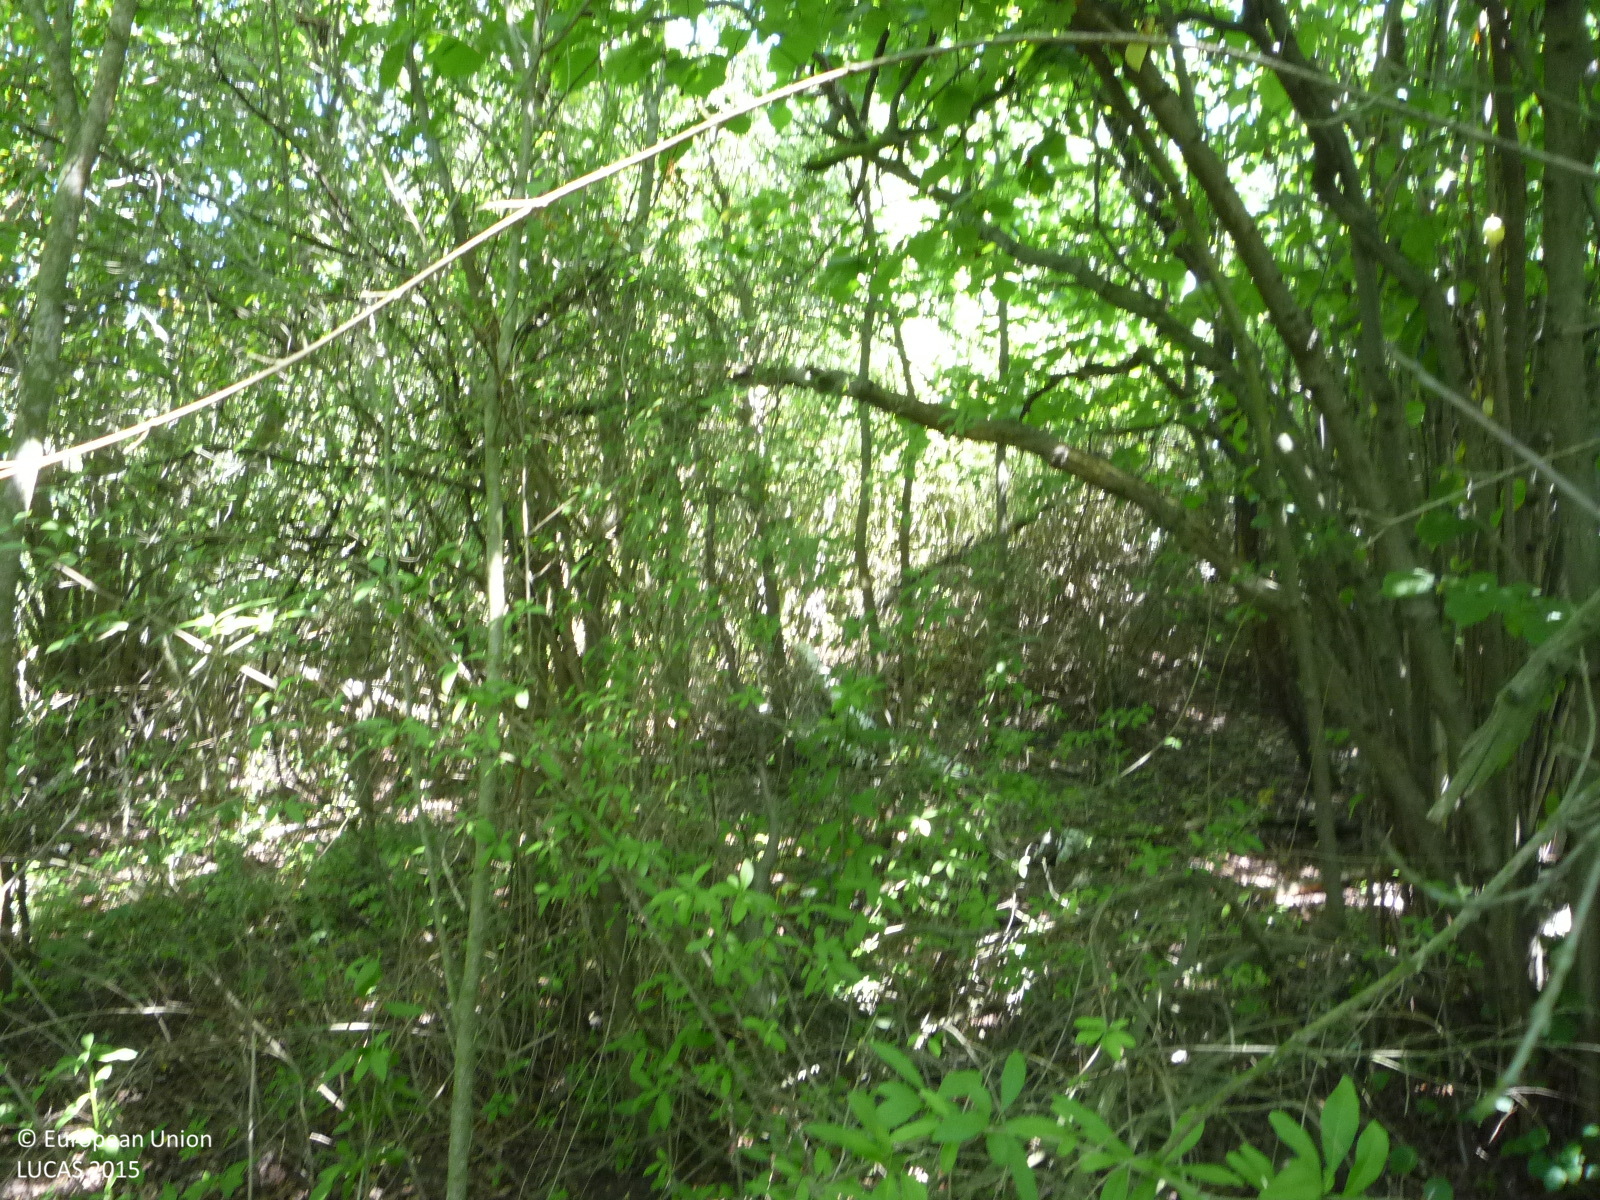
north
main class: Cropland
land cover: Other fruit trees and berries
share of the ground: > 75 %
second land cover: Spontaneously vegetated surfaces
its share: 10 - 25 %
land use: Abandoned areas
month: July
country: CZ
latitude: 50.4031
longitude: 14.4617
